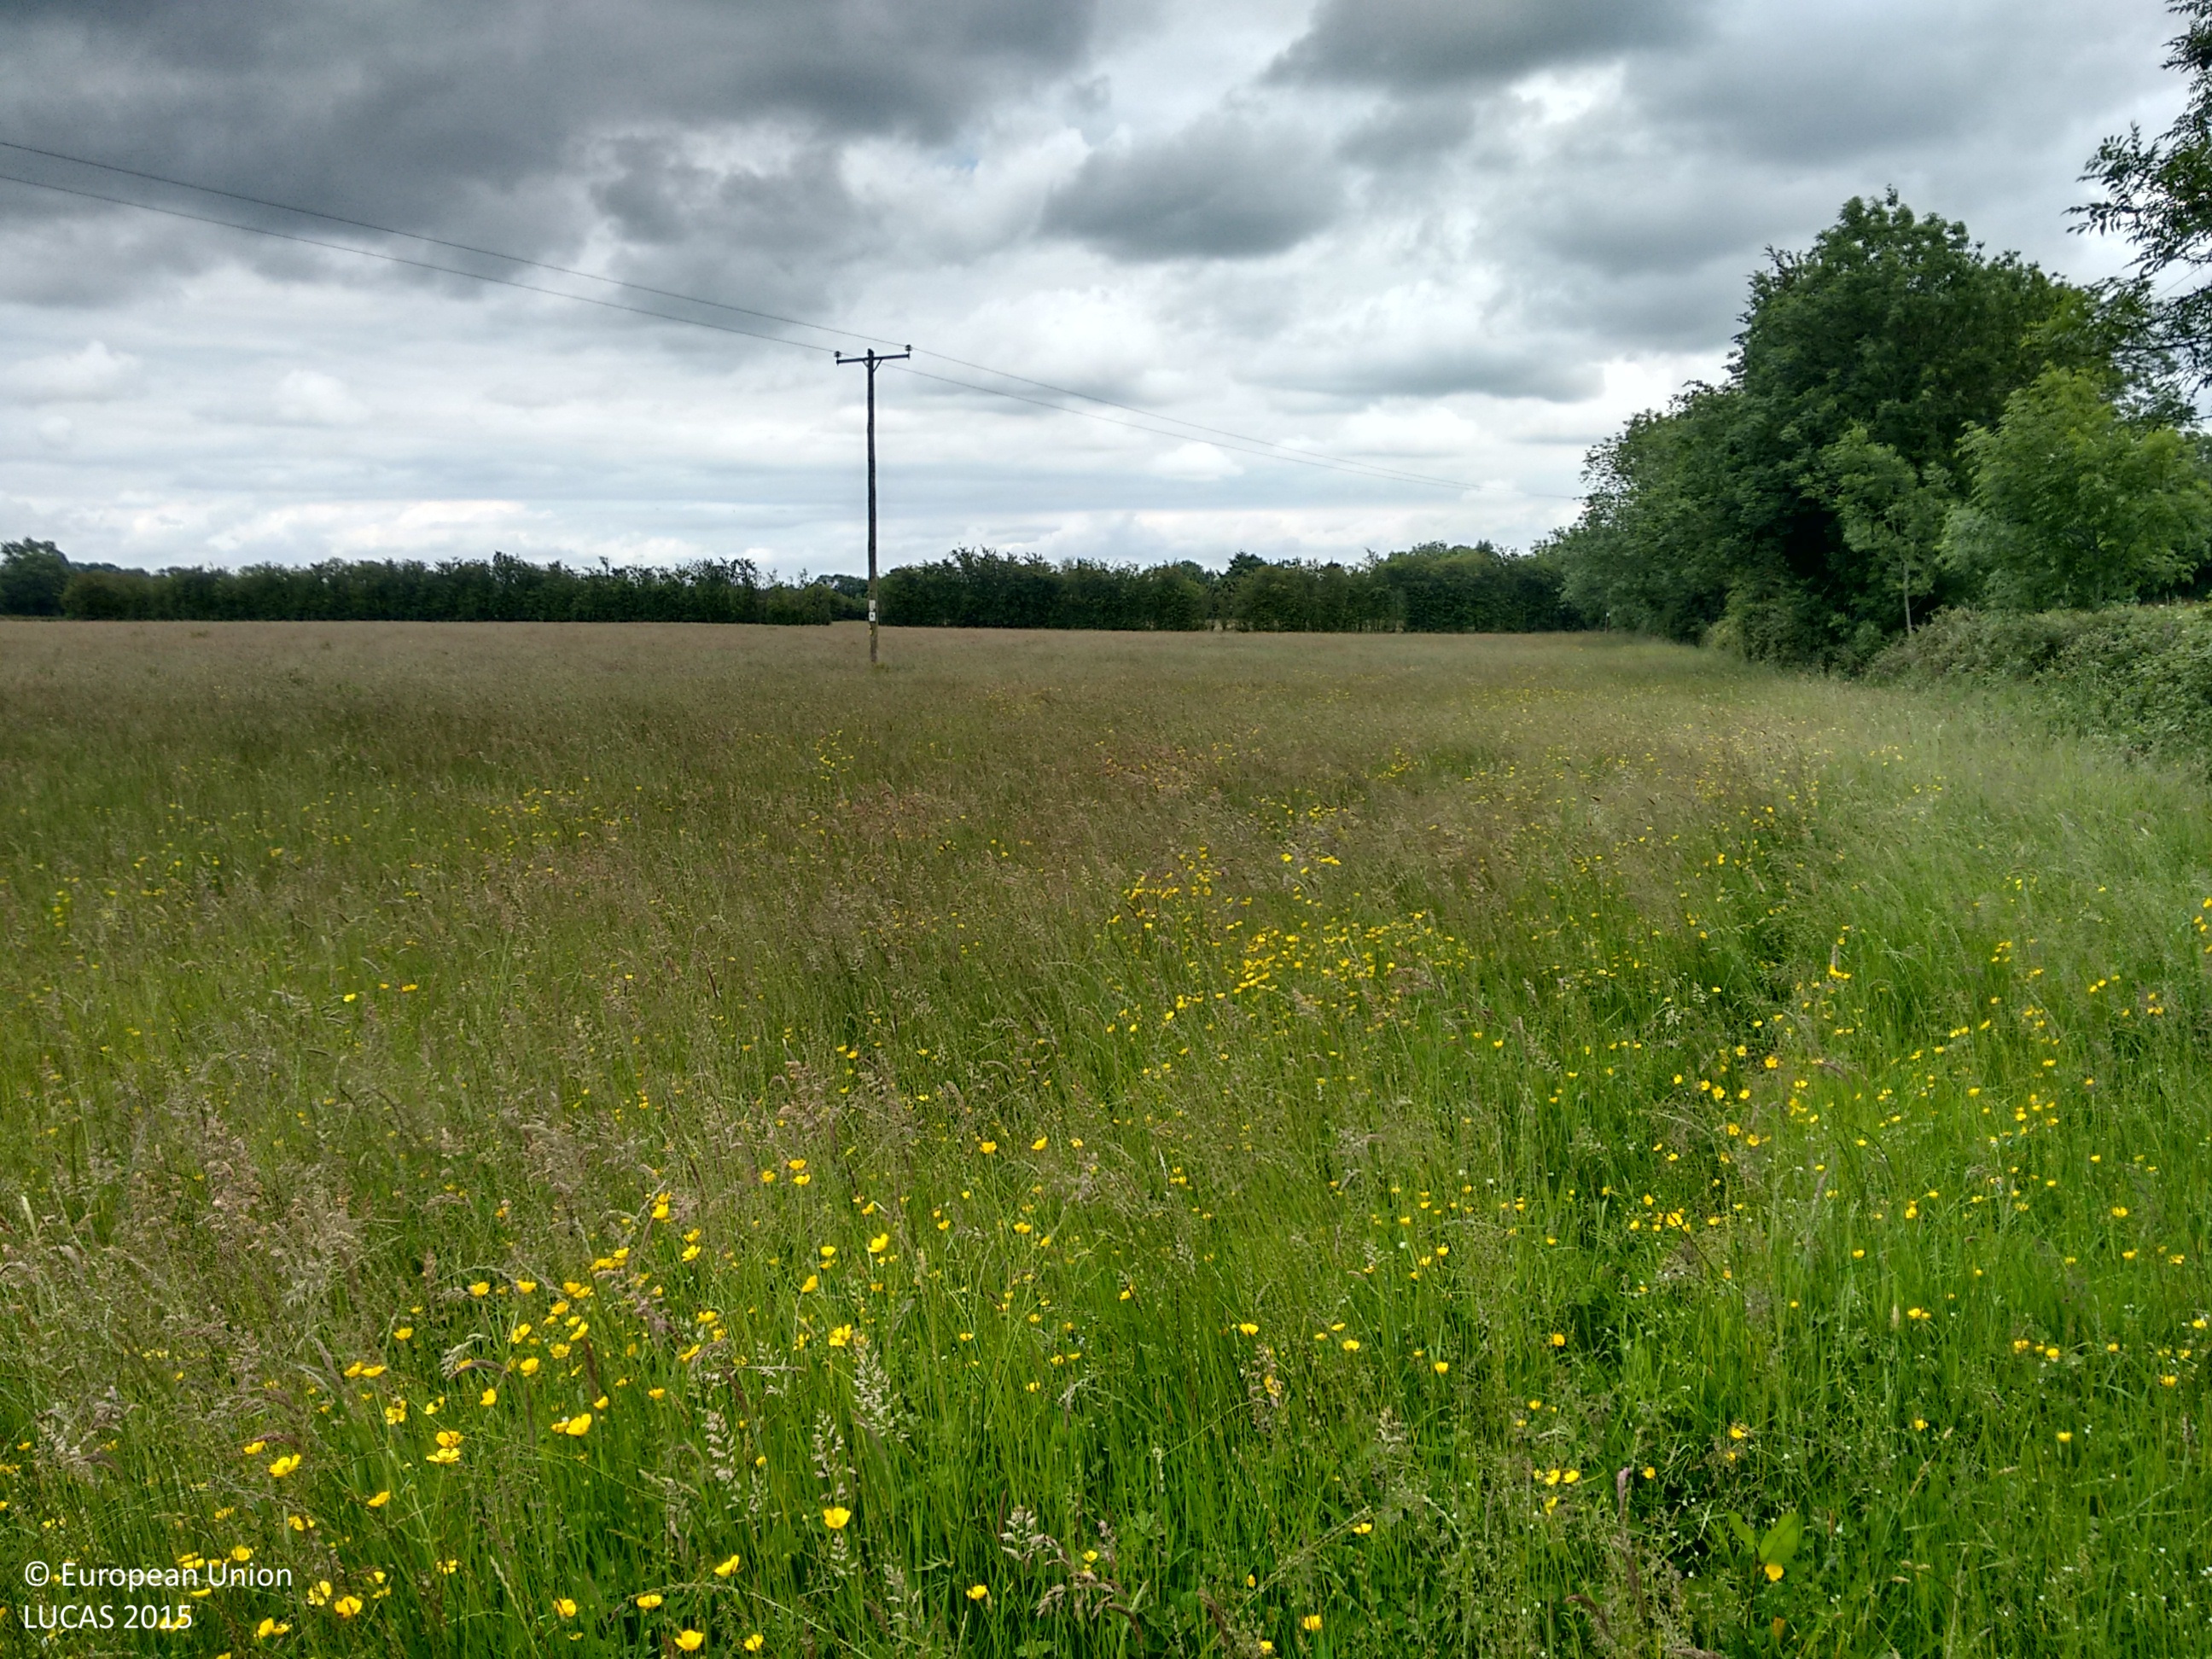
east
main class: Grassland
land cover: Grassland without tree/shrub cover
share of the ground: > 75 %
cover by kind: herbaceous plants 100 %
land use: Agriculture (excluding fallow land and kitchen gardens)
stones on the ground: < 10 %
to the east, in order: Grassland without tree/shrub cover; Electric lines; Grassland without tree/shrub cover; Managed hedges; Grassland without tree/shrub cover; Managed hedges
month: June
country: IE
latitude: 53.6208
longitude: -6.7491
